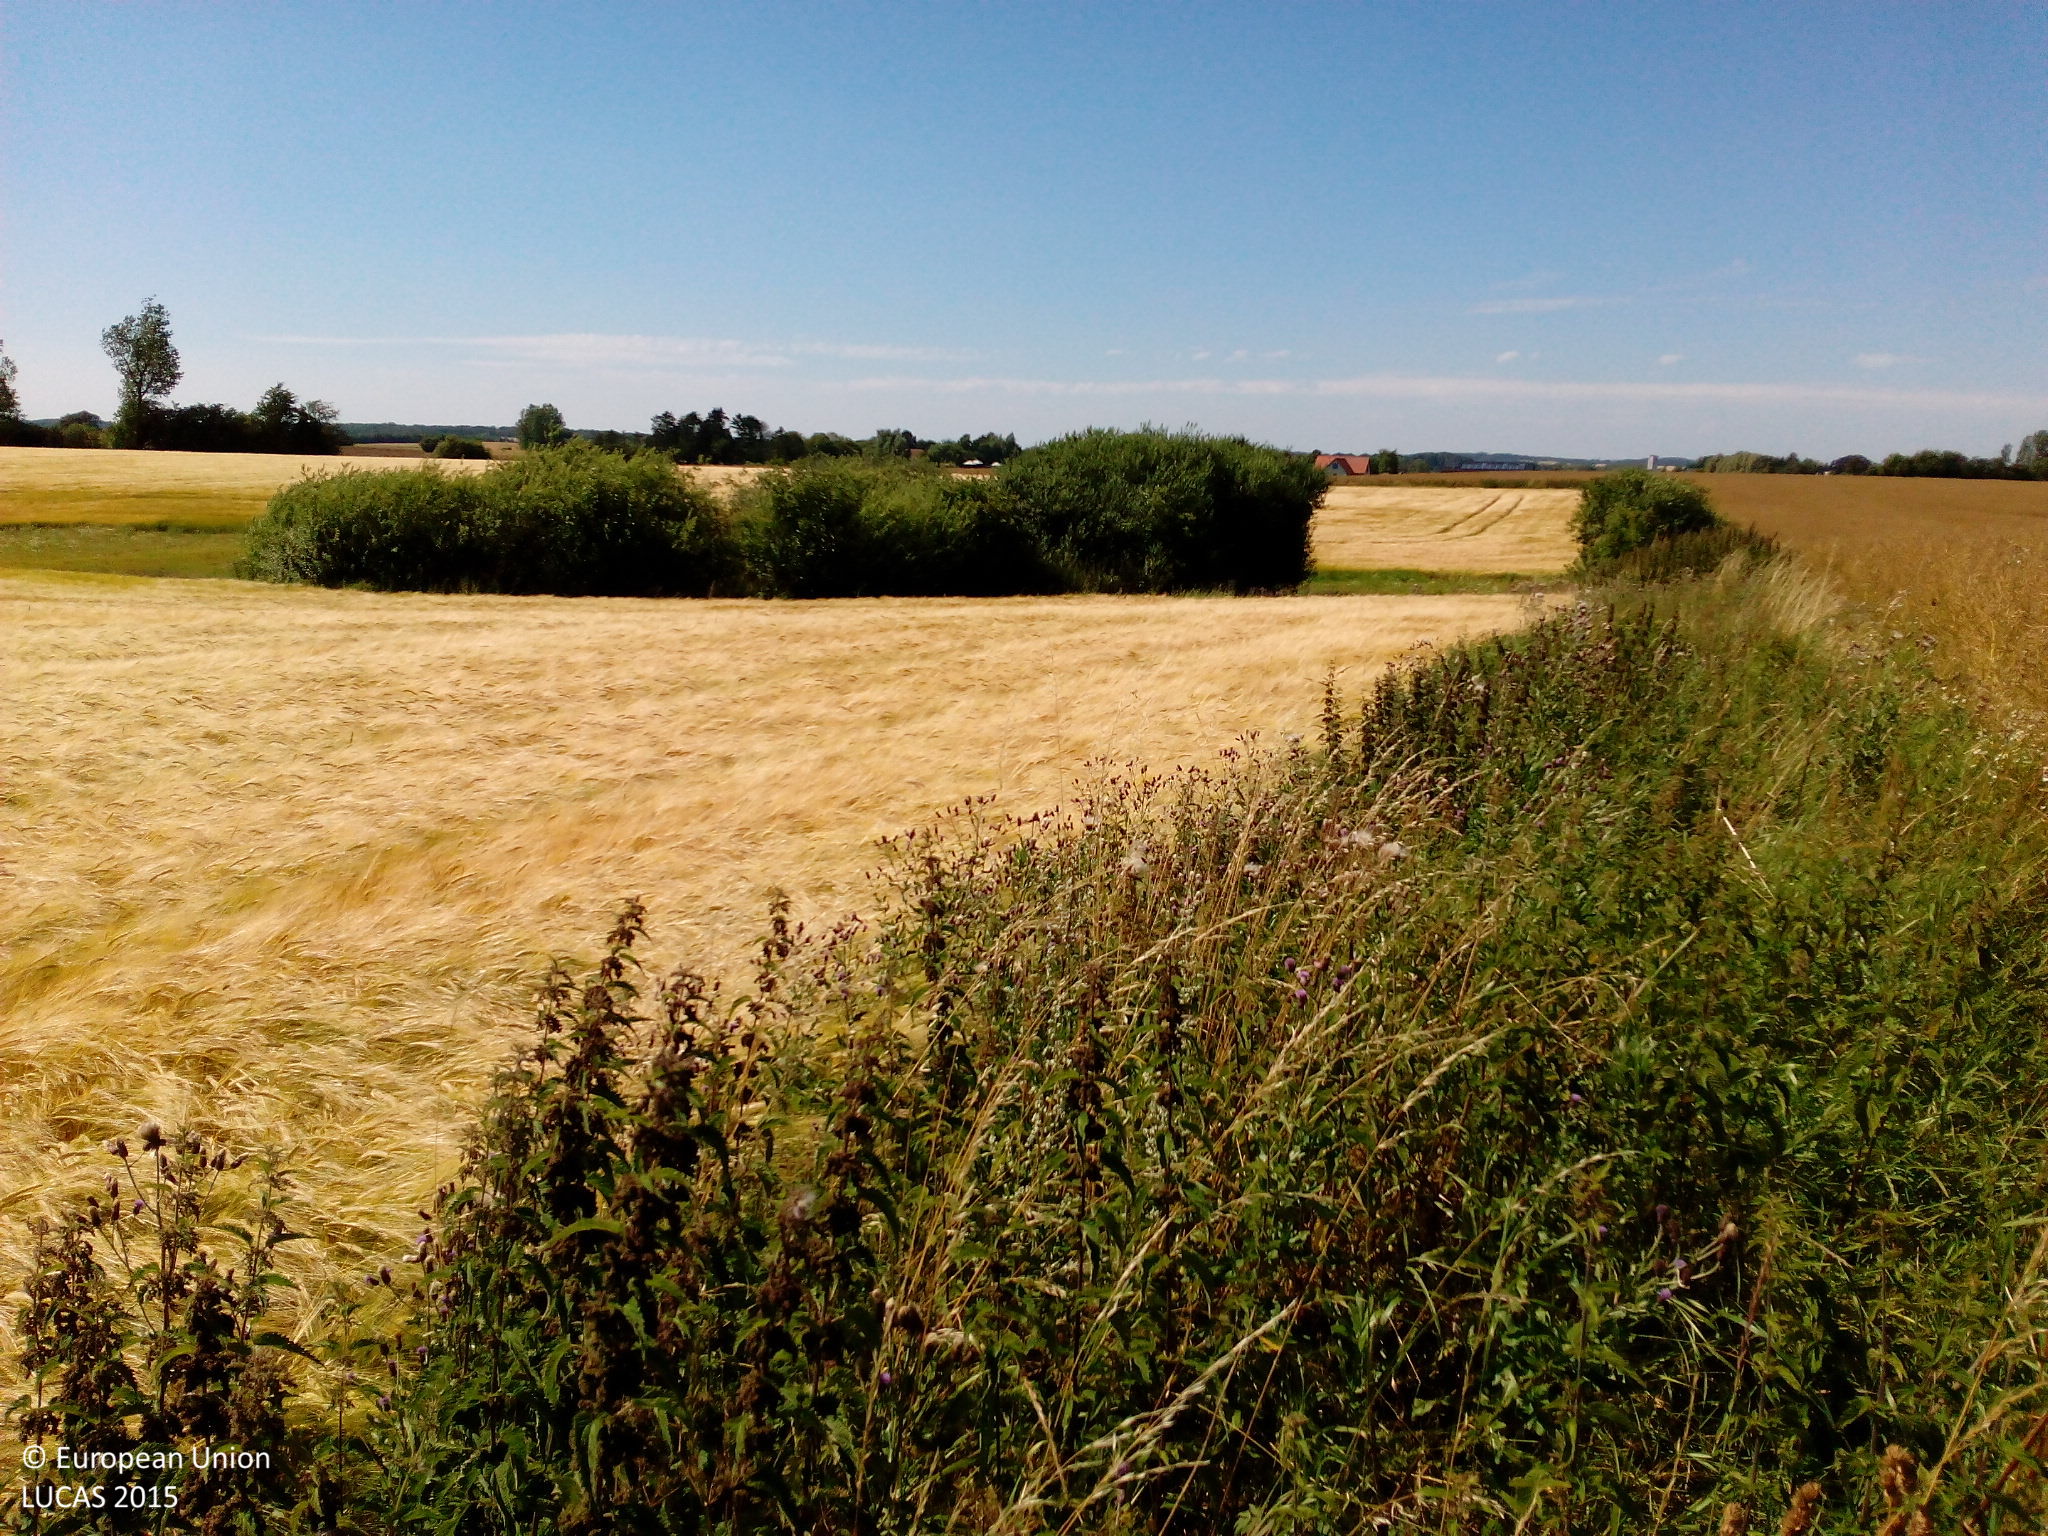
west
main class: Cropland
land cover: Rape and turnip rape
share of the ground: > 75 %
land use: Agriculture (excluding fallow land and kitchen gardens)
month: August
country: DK
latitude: 55.5999
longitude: 11.7918
